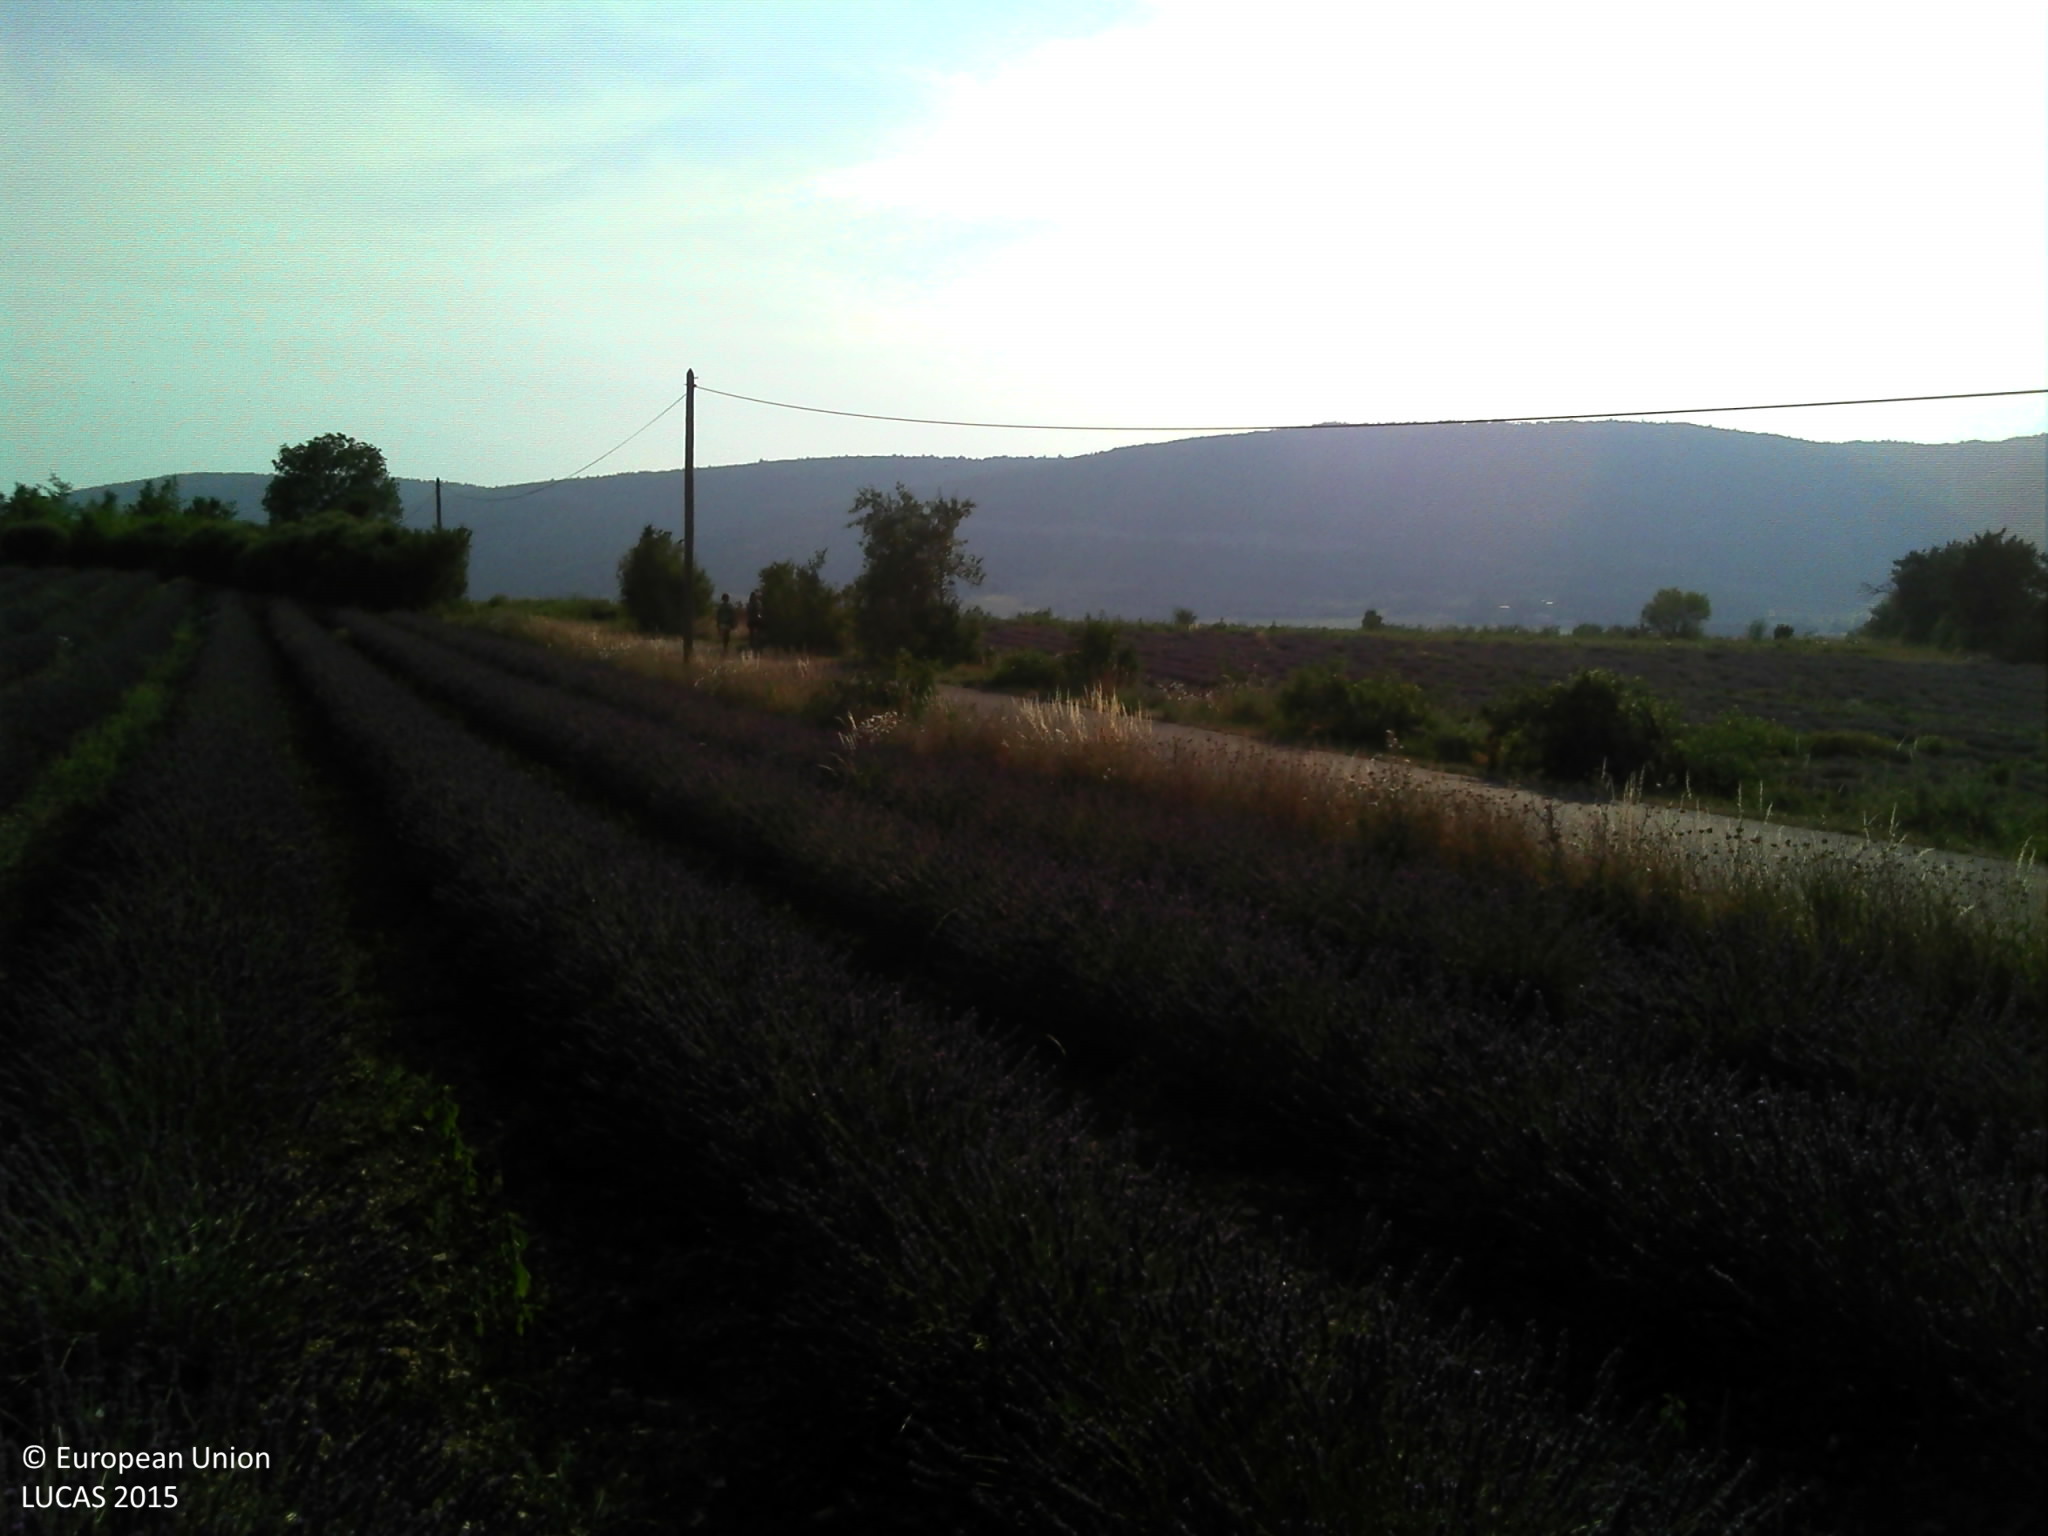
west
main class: Cropland
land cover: Permanent industrial crops
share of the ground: > 75 %
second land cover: Other bare soil
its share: > 75 %
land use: Agriculture (excluding fallow land and kitchen gardens)
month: July
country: FR
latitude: 44.0860
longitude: 5.3997
